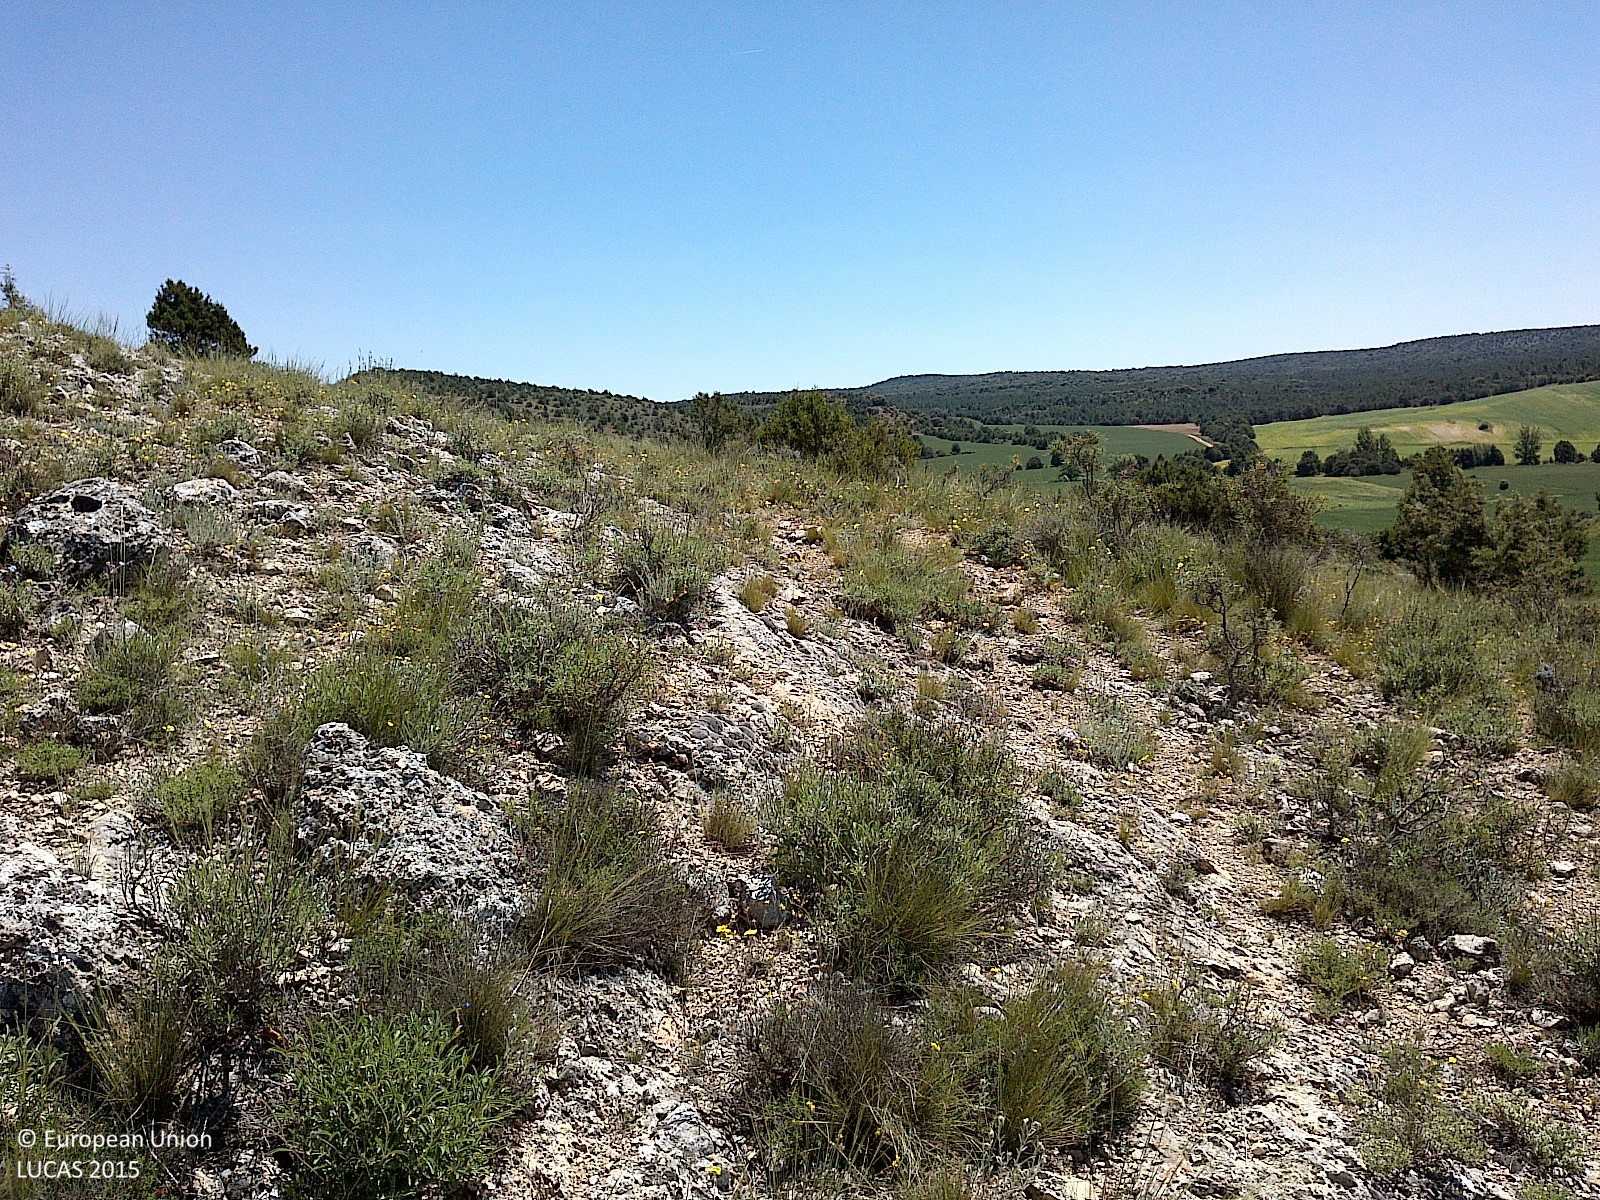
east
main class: Shrubland
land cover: Shrubland without tree cover
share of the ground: 50 - 75 %
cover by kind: shrubs 55 %, consolidated bare surface 35 %, herbaceous plants 10 %
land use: Semi-natural and natural areas not in use
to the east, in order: Shrubland without tree cover; Shrubland with sparse tree cover; Common wheat; Grassland without tree/shrub cover; Rivers and streams; Grassland without tree/shrub cover; Barley
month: May
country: ES
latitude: 41.5676
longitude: -3.0542
